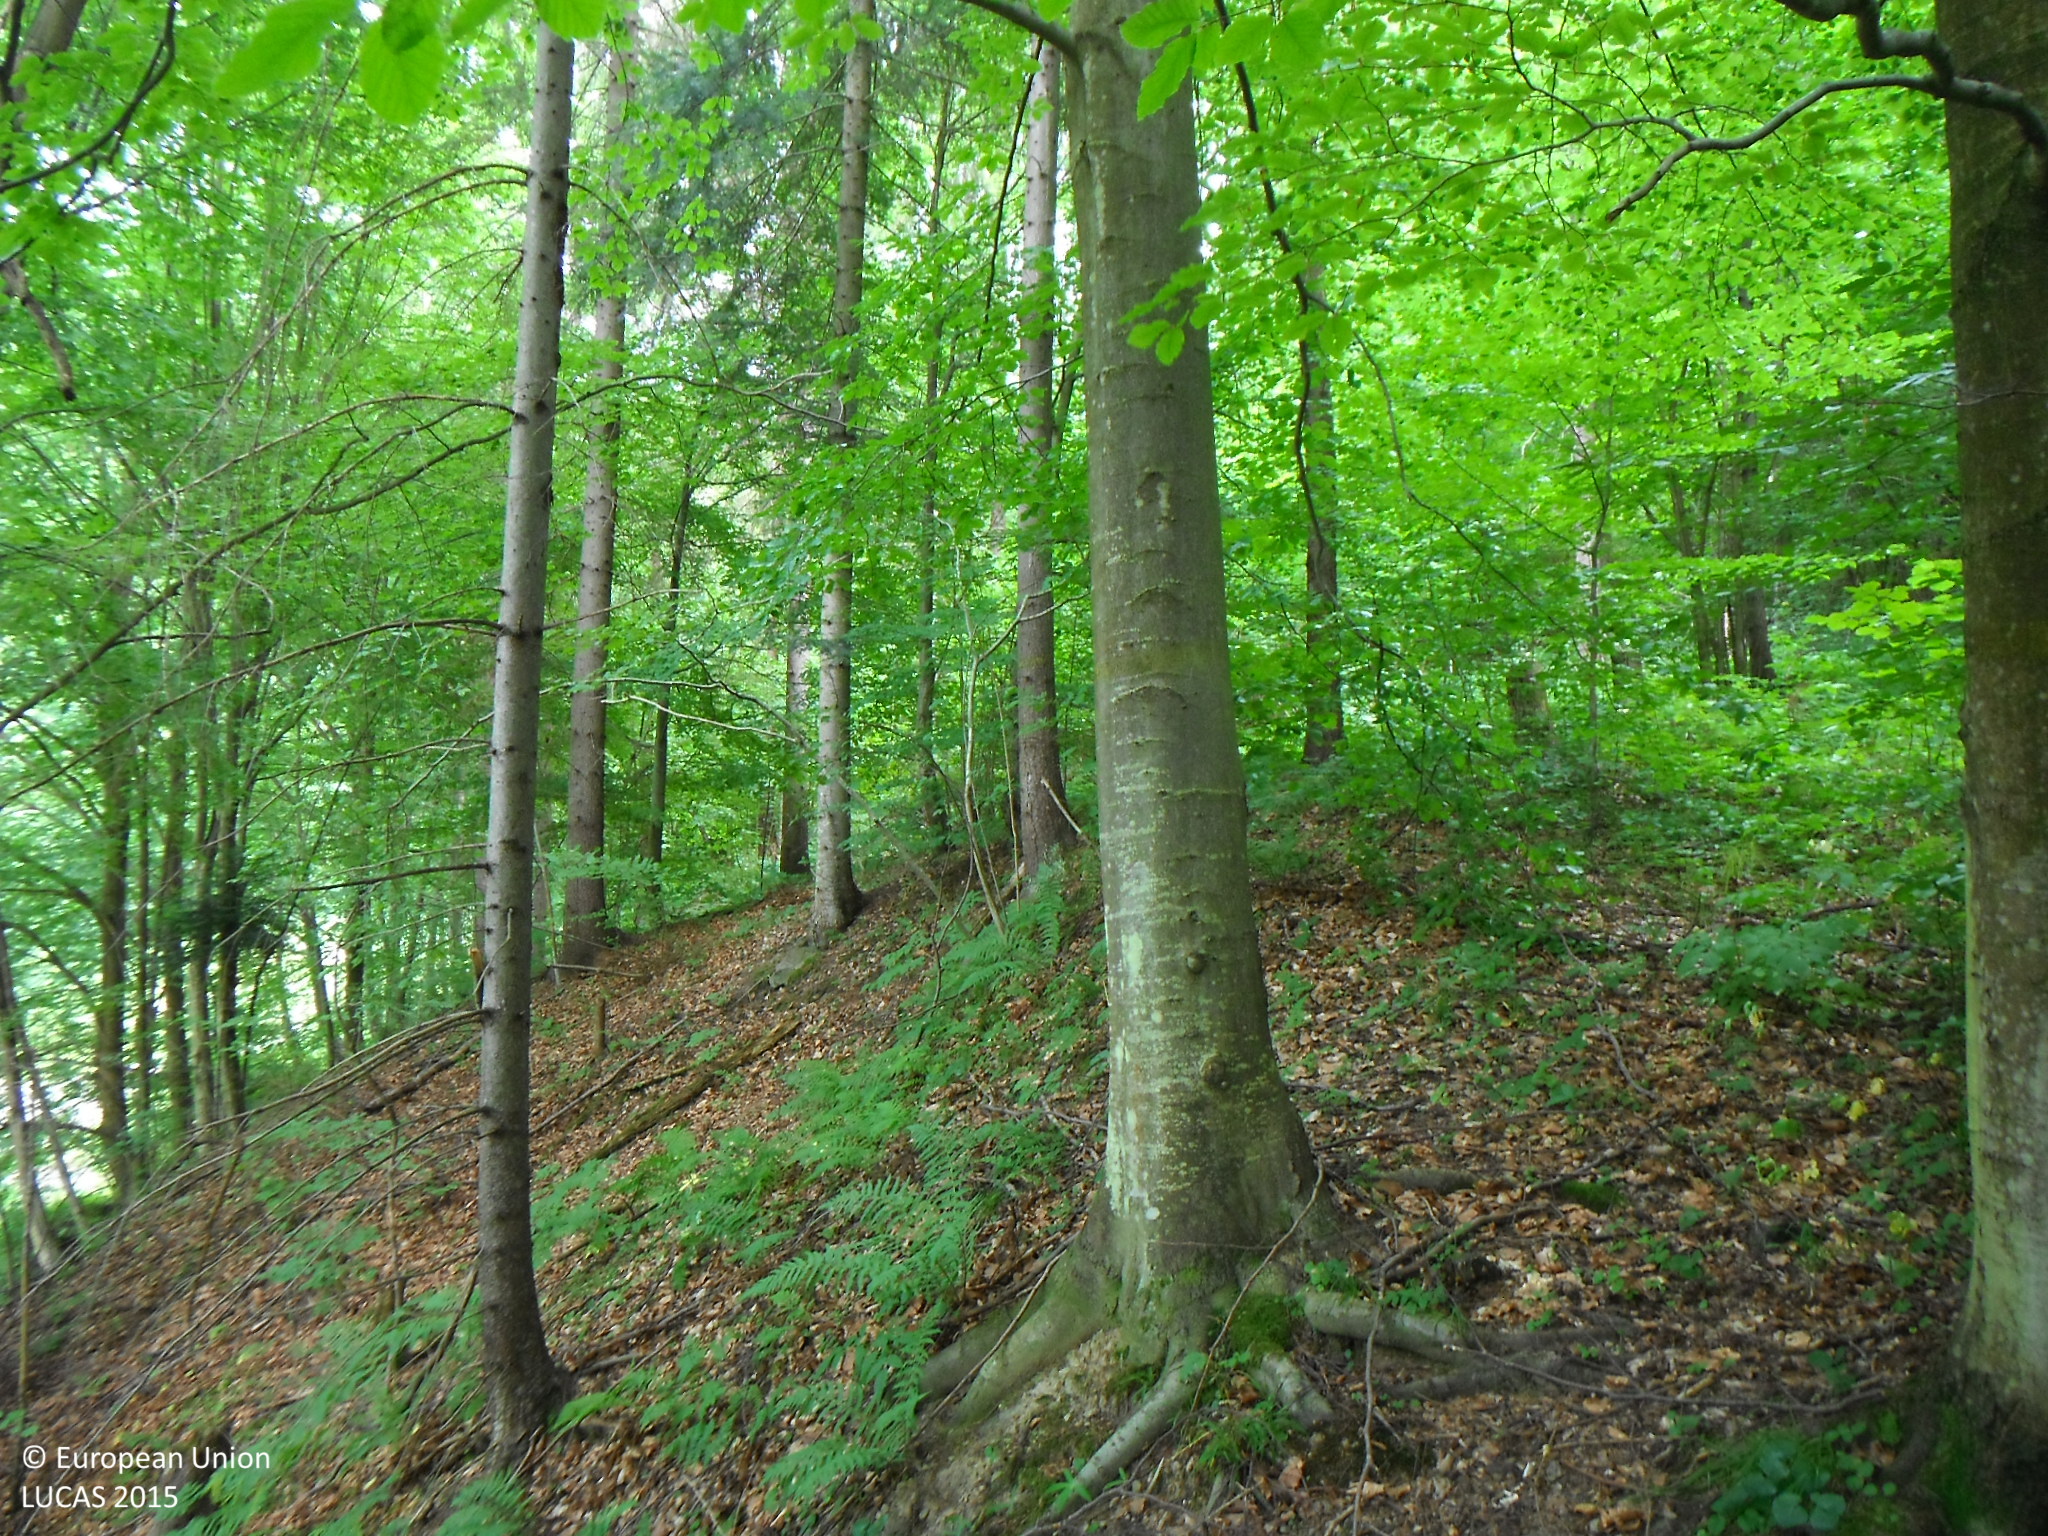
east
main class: Woodland
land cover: Broadleaved woodland
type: beech forest
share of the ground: > 75 %
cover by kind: broadleaved forest trees 100 %
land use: Forestry
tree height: > 5 m
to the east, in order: Broadleaved woodland; Spruce dominated mixed woodland
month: July
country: SK
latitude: 49.2764
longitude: 21.1088
